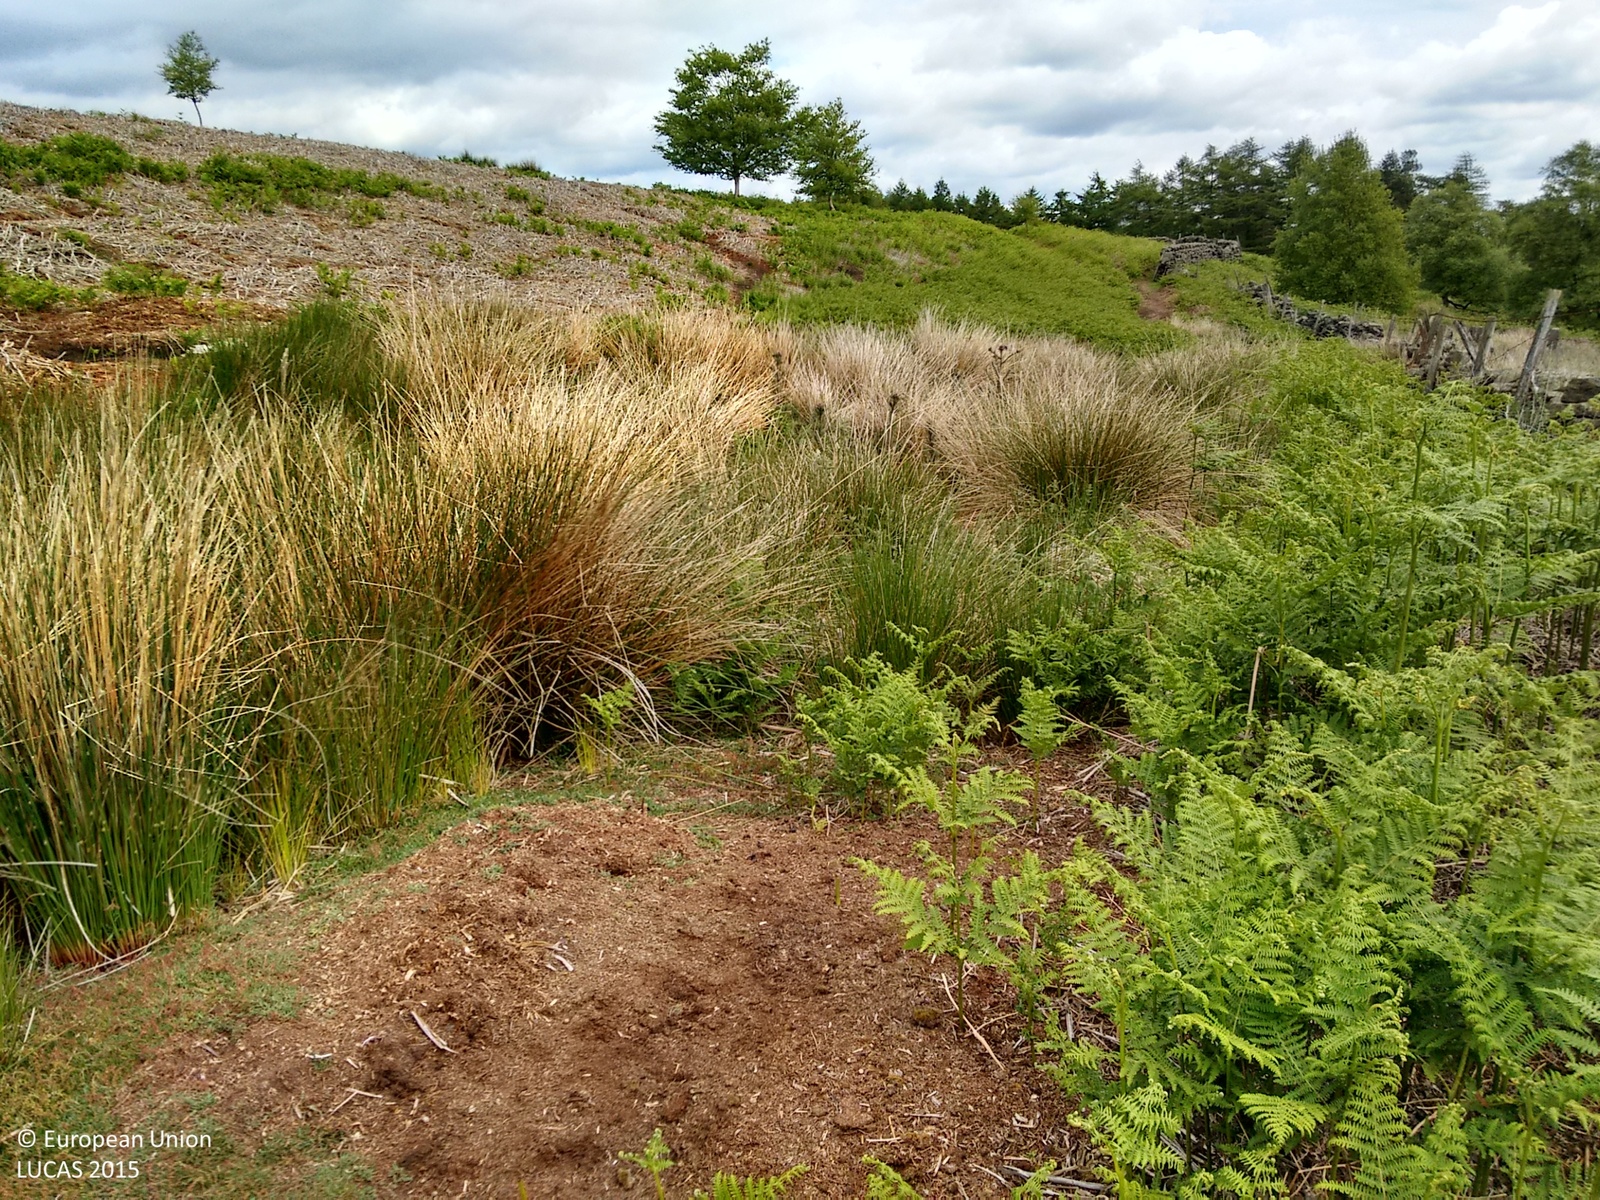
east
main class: Grassland
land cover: Grassland without tree/shrub cover
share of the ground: > 75 %
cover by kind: herbaceous plants 100 %
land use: Agriculture (excluding fallow land and kitchen gardens)
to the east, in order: Grassland without tree/shrub cover; Fences; Grassland with sparse tree/shrub cover; Fences; Dry stone walls; Broadleaved woodland; Fences; Pine dominated mixed woodland
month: June
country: GB
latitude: 54.3488
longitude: -1.2297
